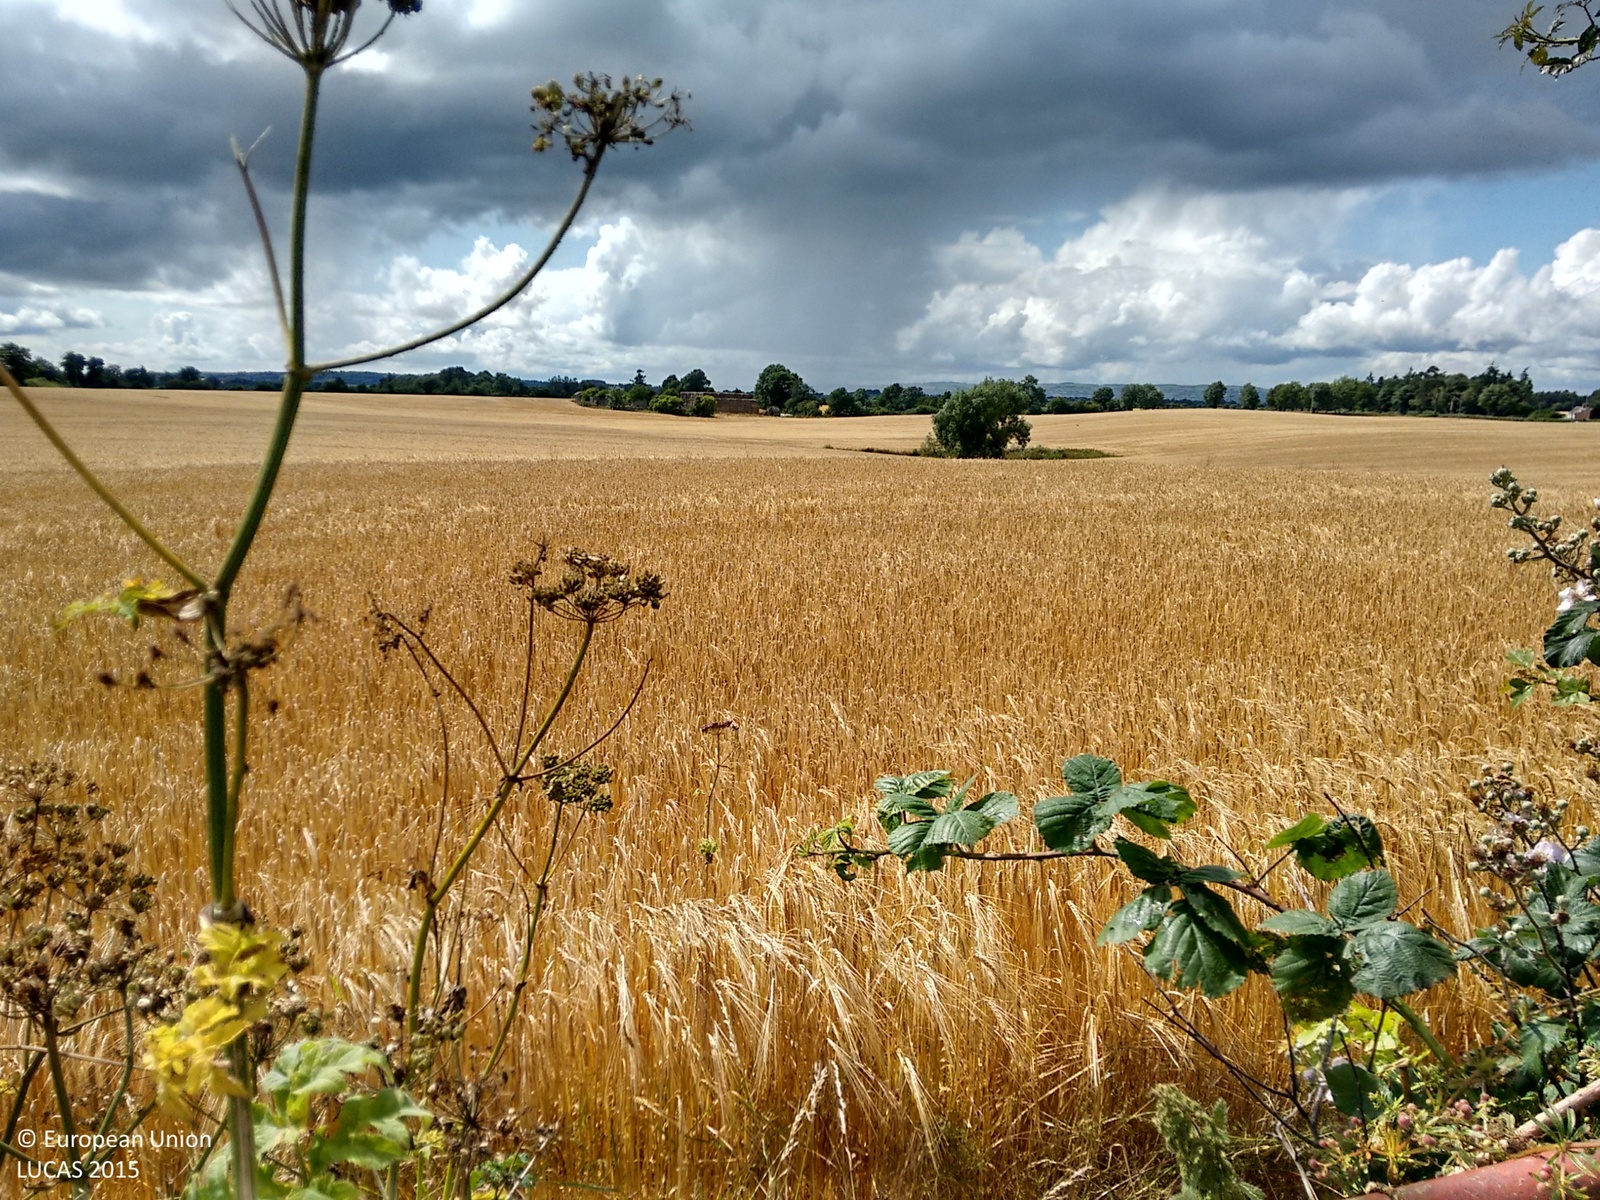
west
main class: Cropland
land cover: Barley
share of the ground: > 75 %
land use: Agriculture (excluding fallow land and kitchen gardens)
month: July
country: IE
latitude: 52.7917
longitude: -6.7588
